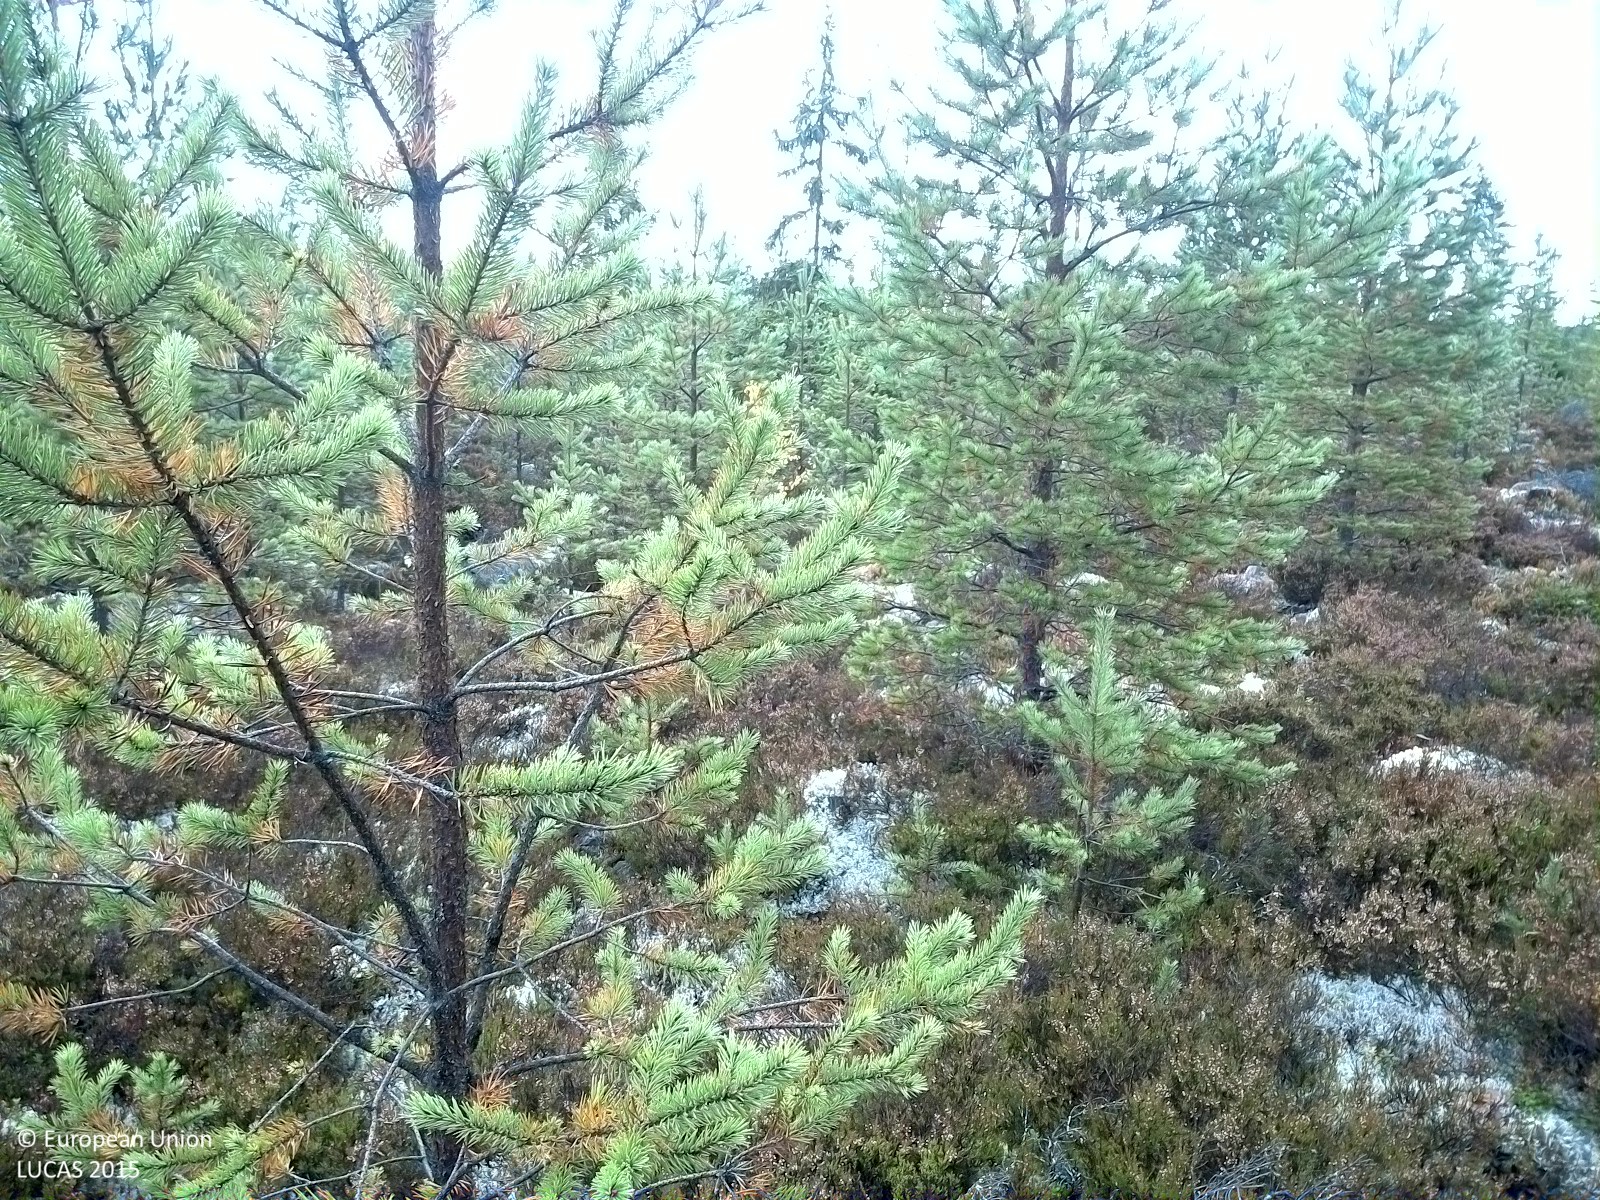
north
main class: Woodland
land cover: Pine dominated coniferous woodland
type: boreal forest
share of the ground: 25 - 50 %
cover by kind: shrubs 65 %, coniferous forest trees 25 %, lichens and mosses 10 %
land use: Forestry
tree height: < 5 m
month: September
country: SE
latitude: 62.1794
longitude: 16.1461
